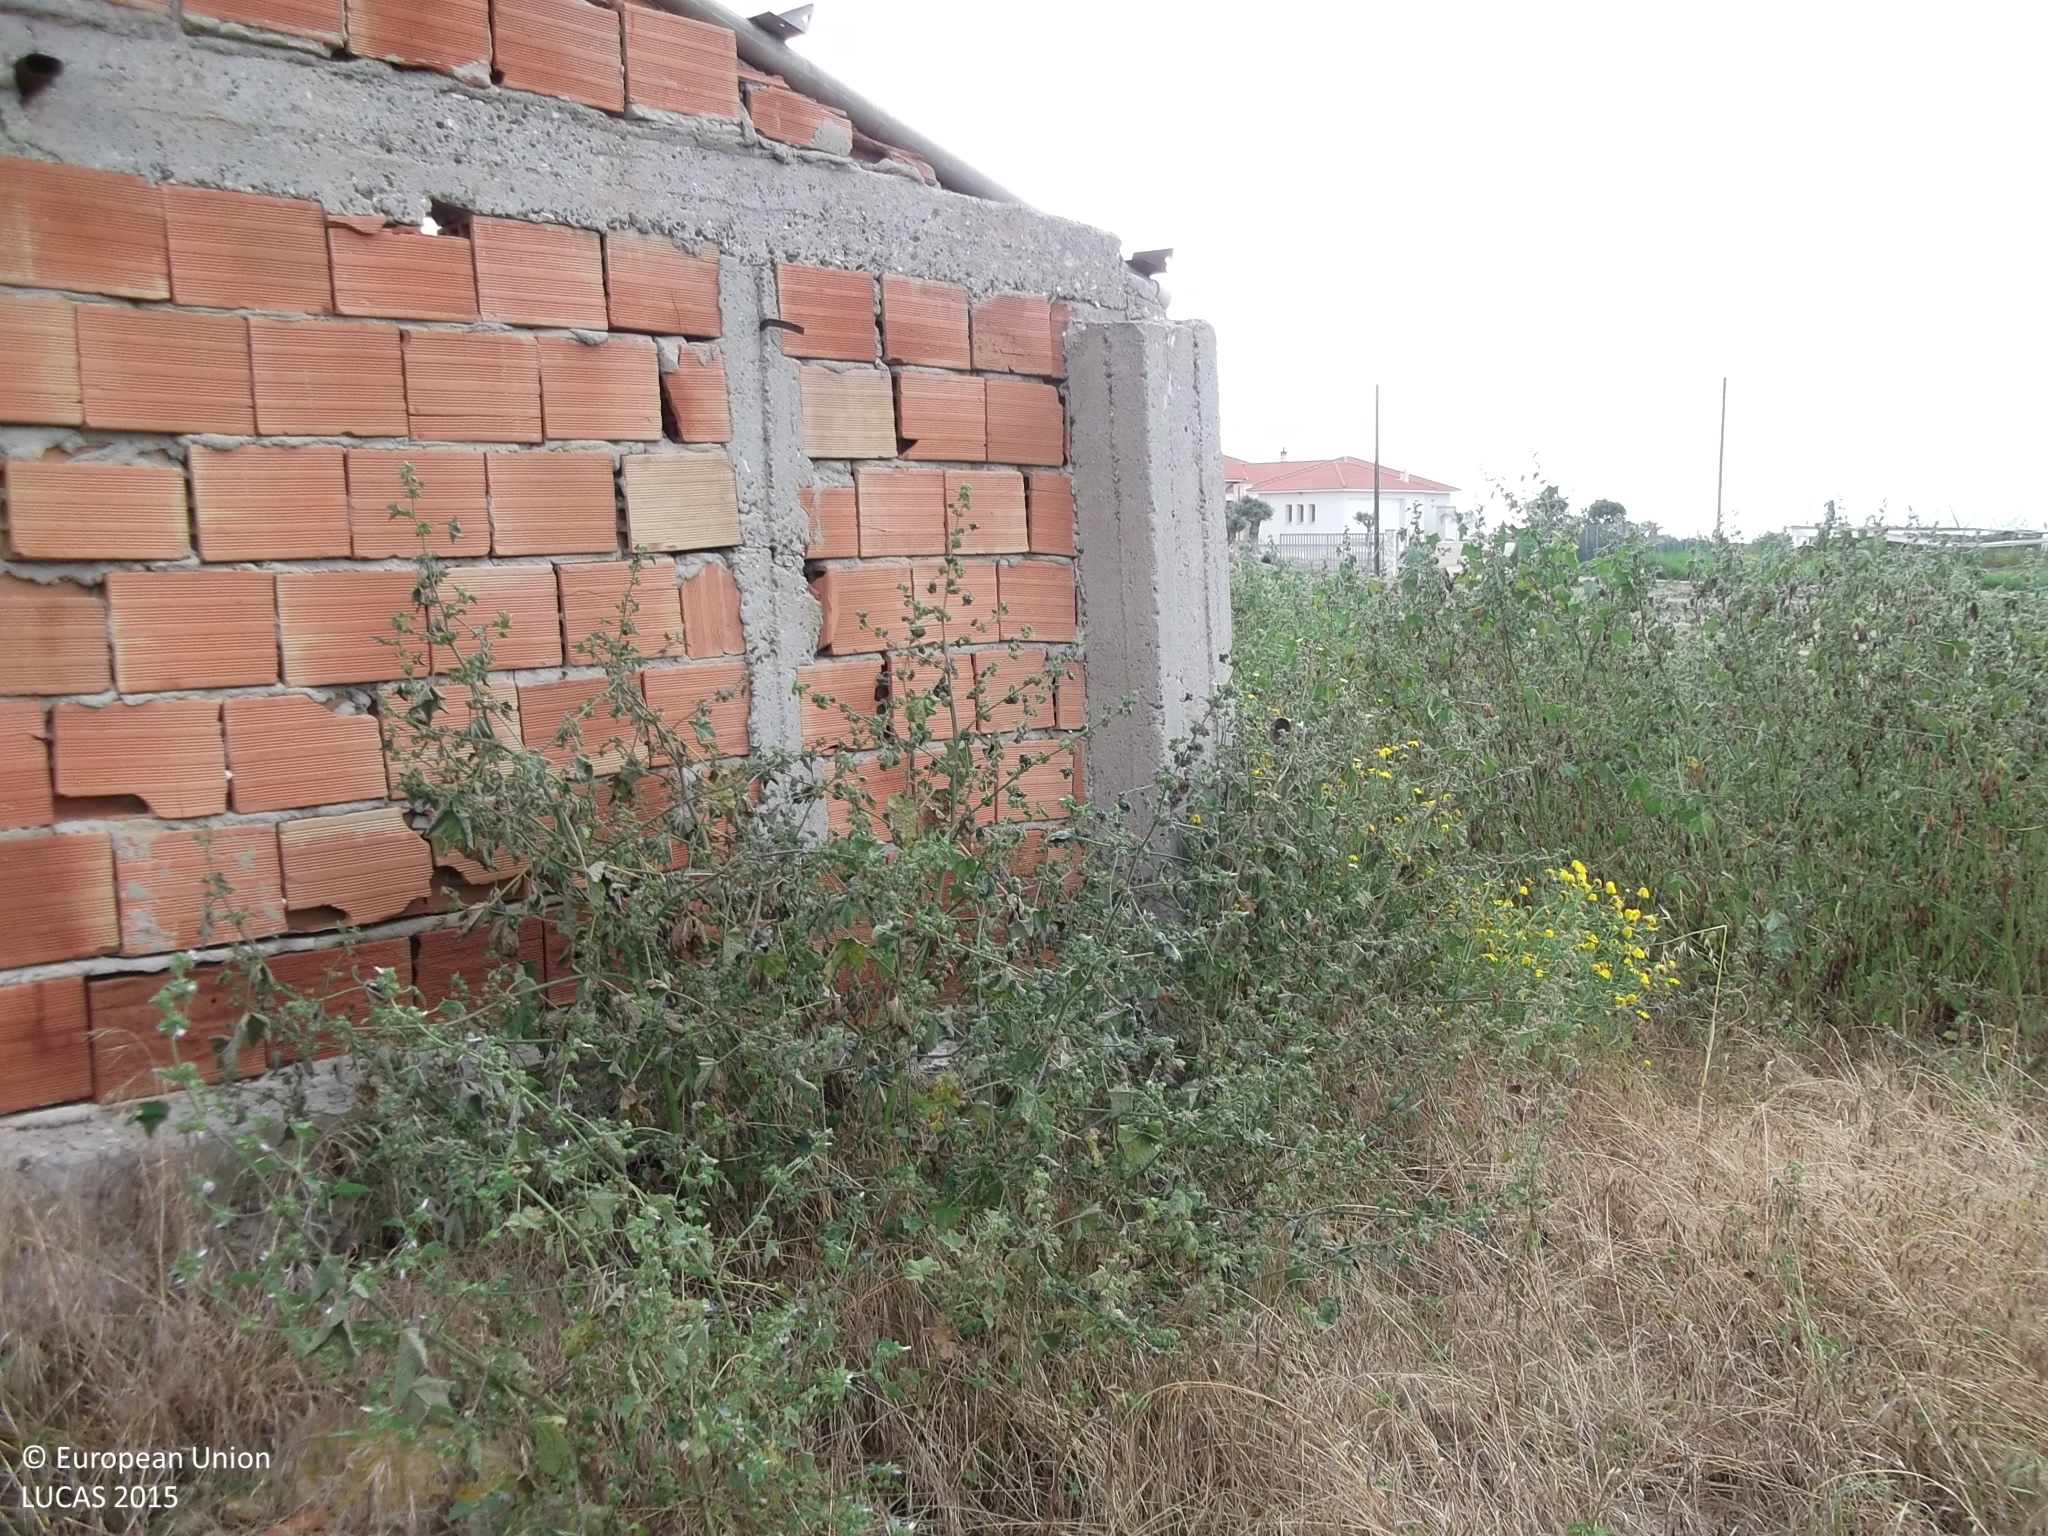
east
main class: Grassland
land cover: Grassland without tree/shrub cover
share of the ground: > 75 %
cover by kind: herbaceous plants 100 %
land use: Abandoned areas
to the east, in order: Grassland without tree/shrub cover; Artificial constructions in urban areas; Grassland without tree/shrub cover; Grassland with sparse tree/shrub cover; Other bare soil; Mixed cereals for fodder; Barley; Grassland with sparse tree/shrub cover; Mixed cereals for fodder
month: April
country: CY
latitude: 34.7960
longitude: 33.5000
